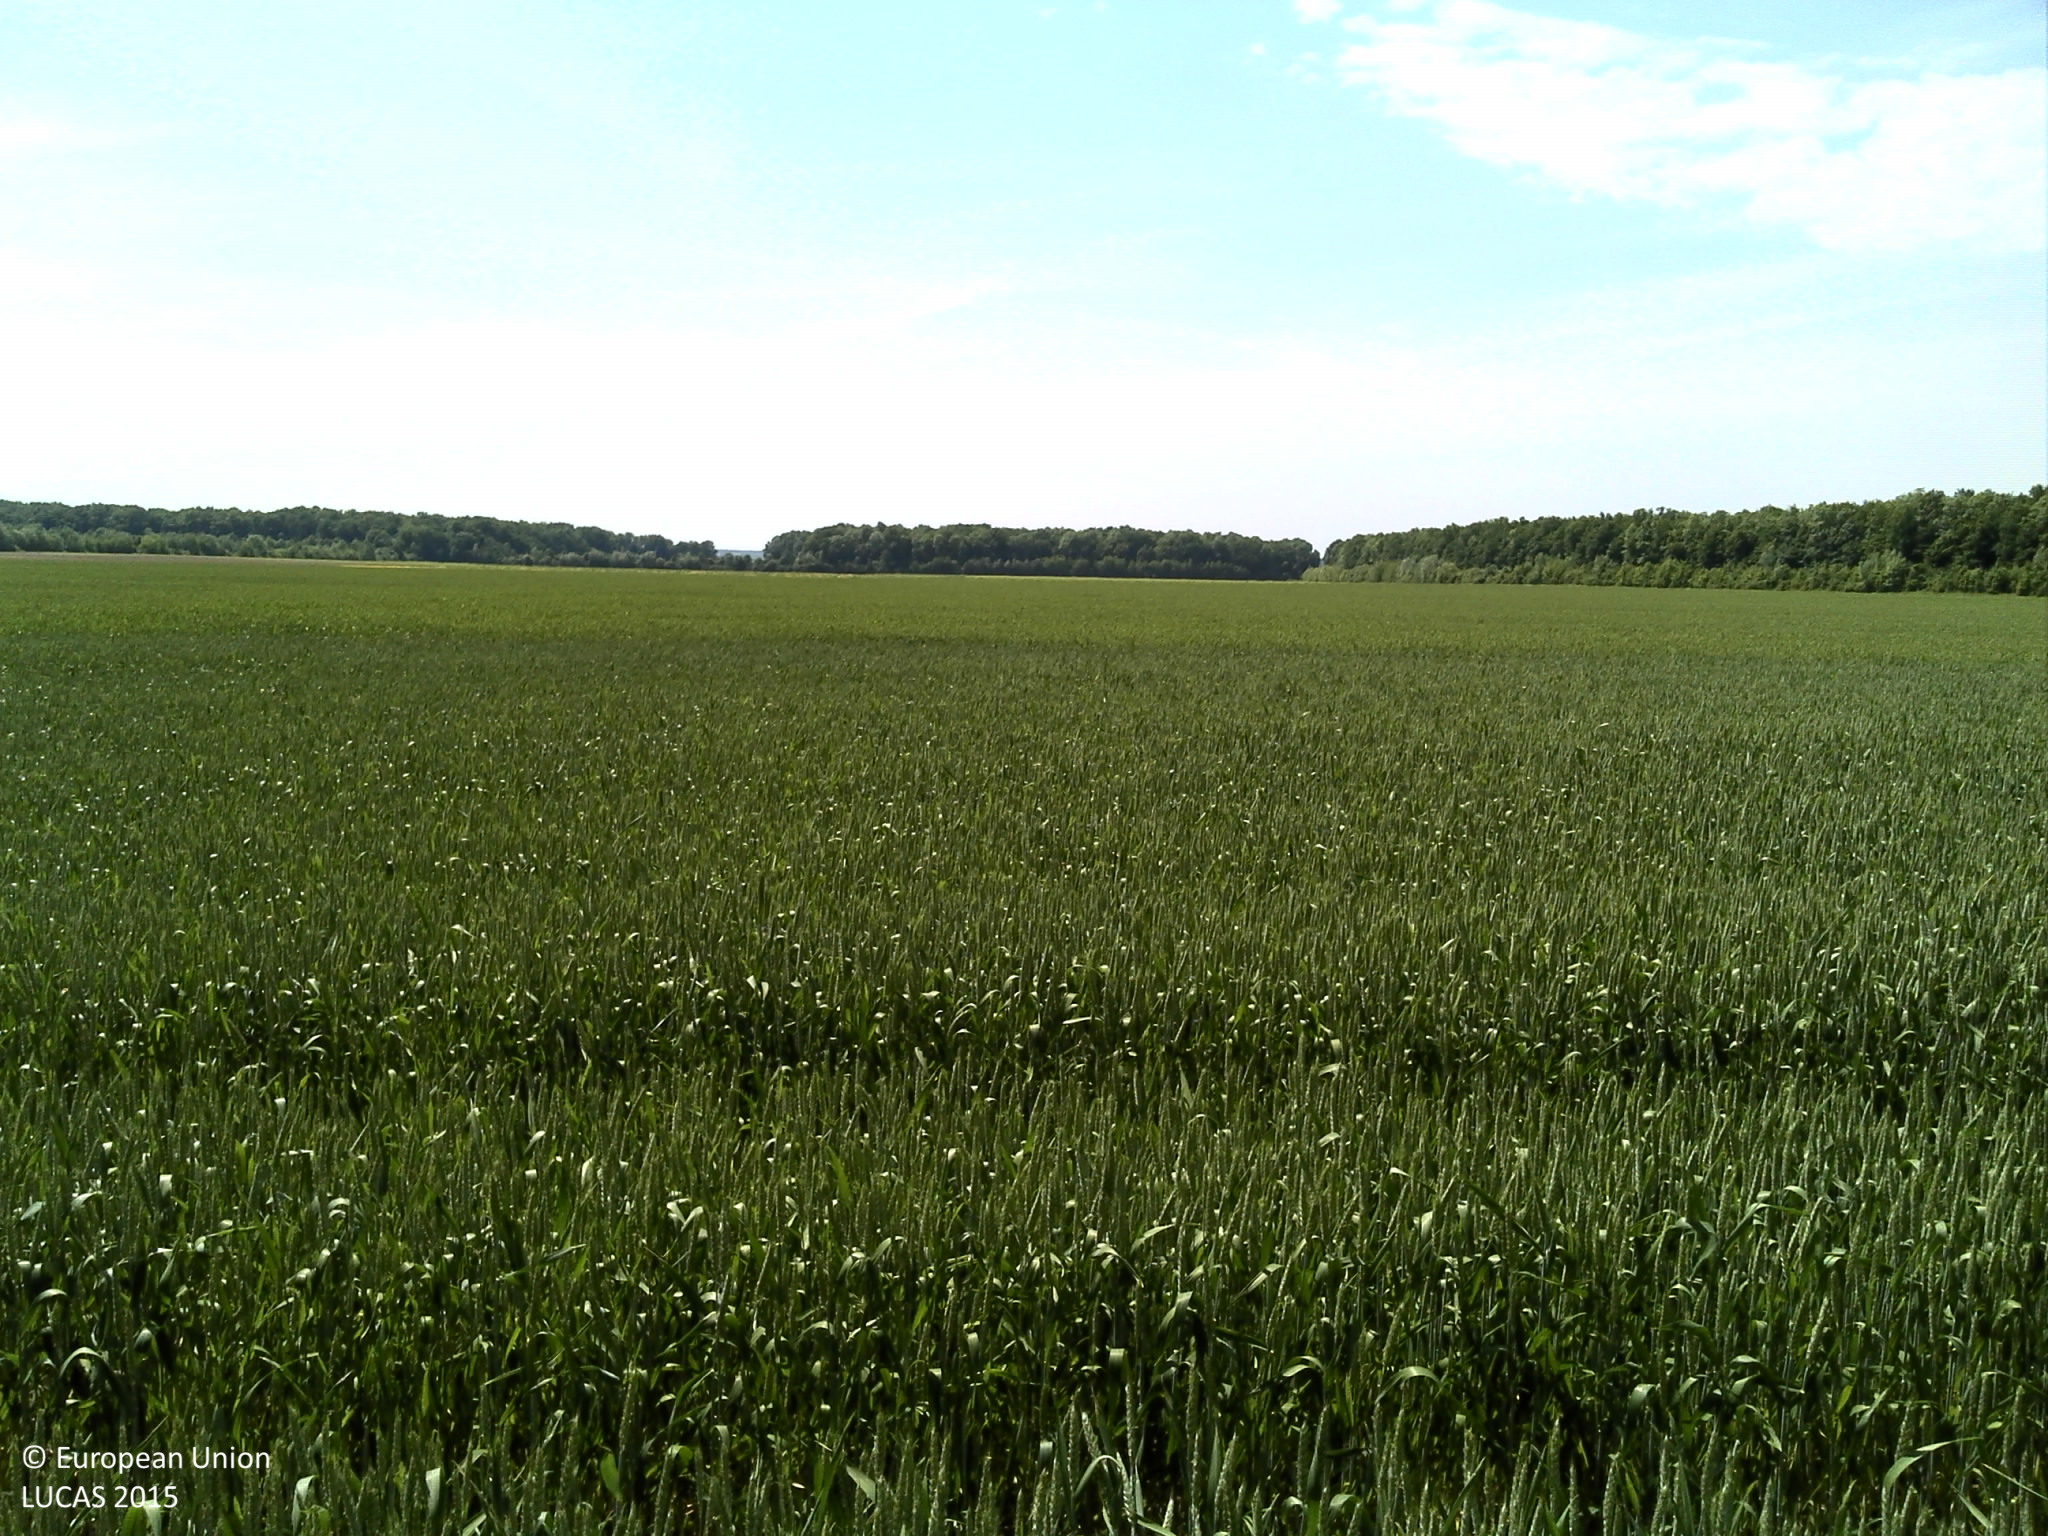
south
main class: Cropland
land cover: Common wheat
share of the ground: > 75 %
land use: Agriculture (excluding fallow land and kitchen gardens)
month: May
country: HR
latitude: 45.5102
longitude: 18.2096
